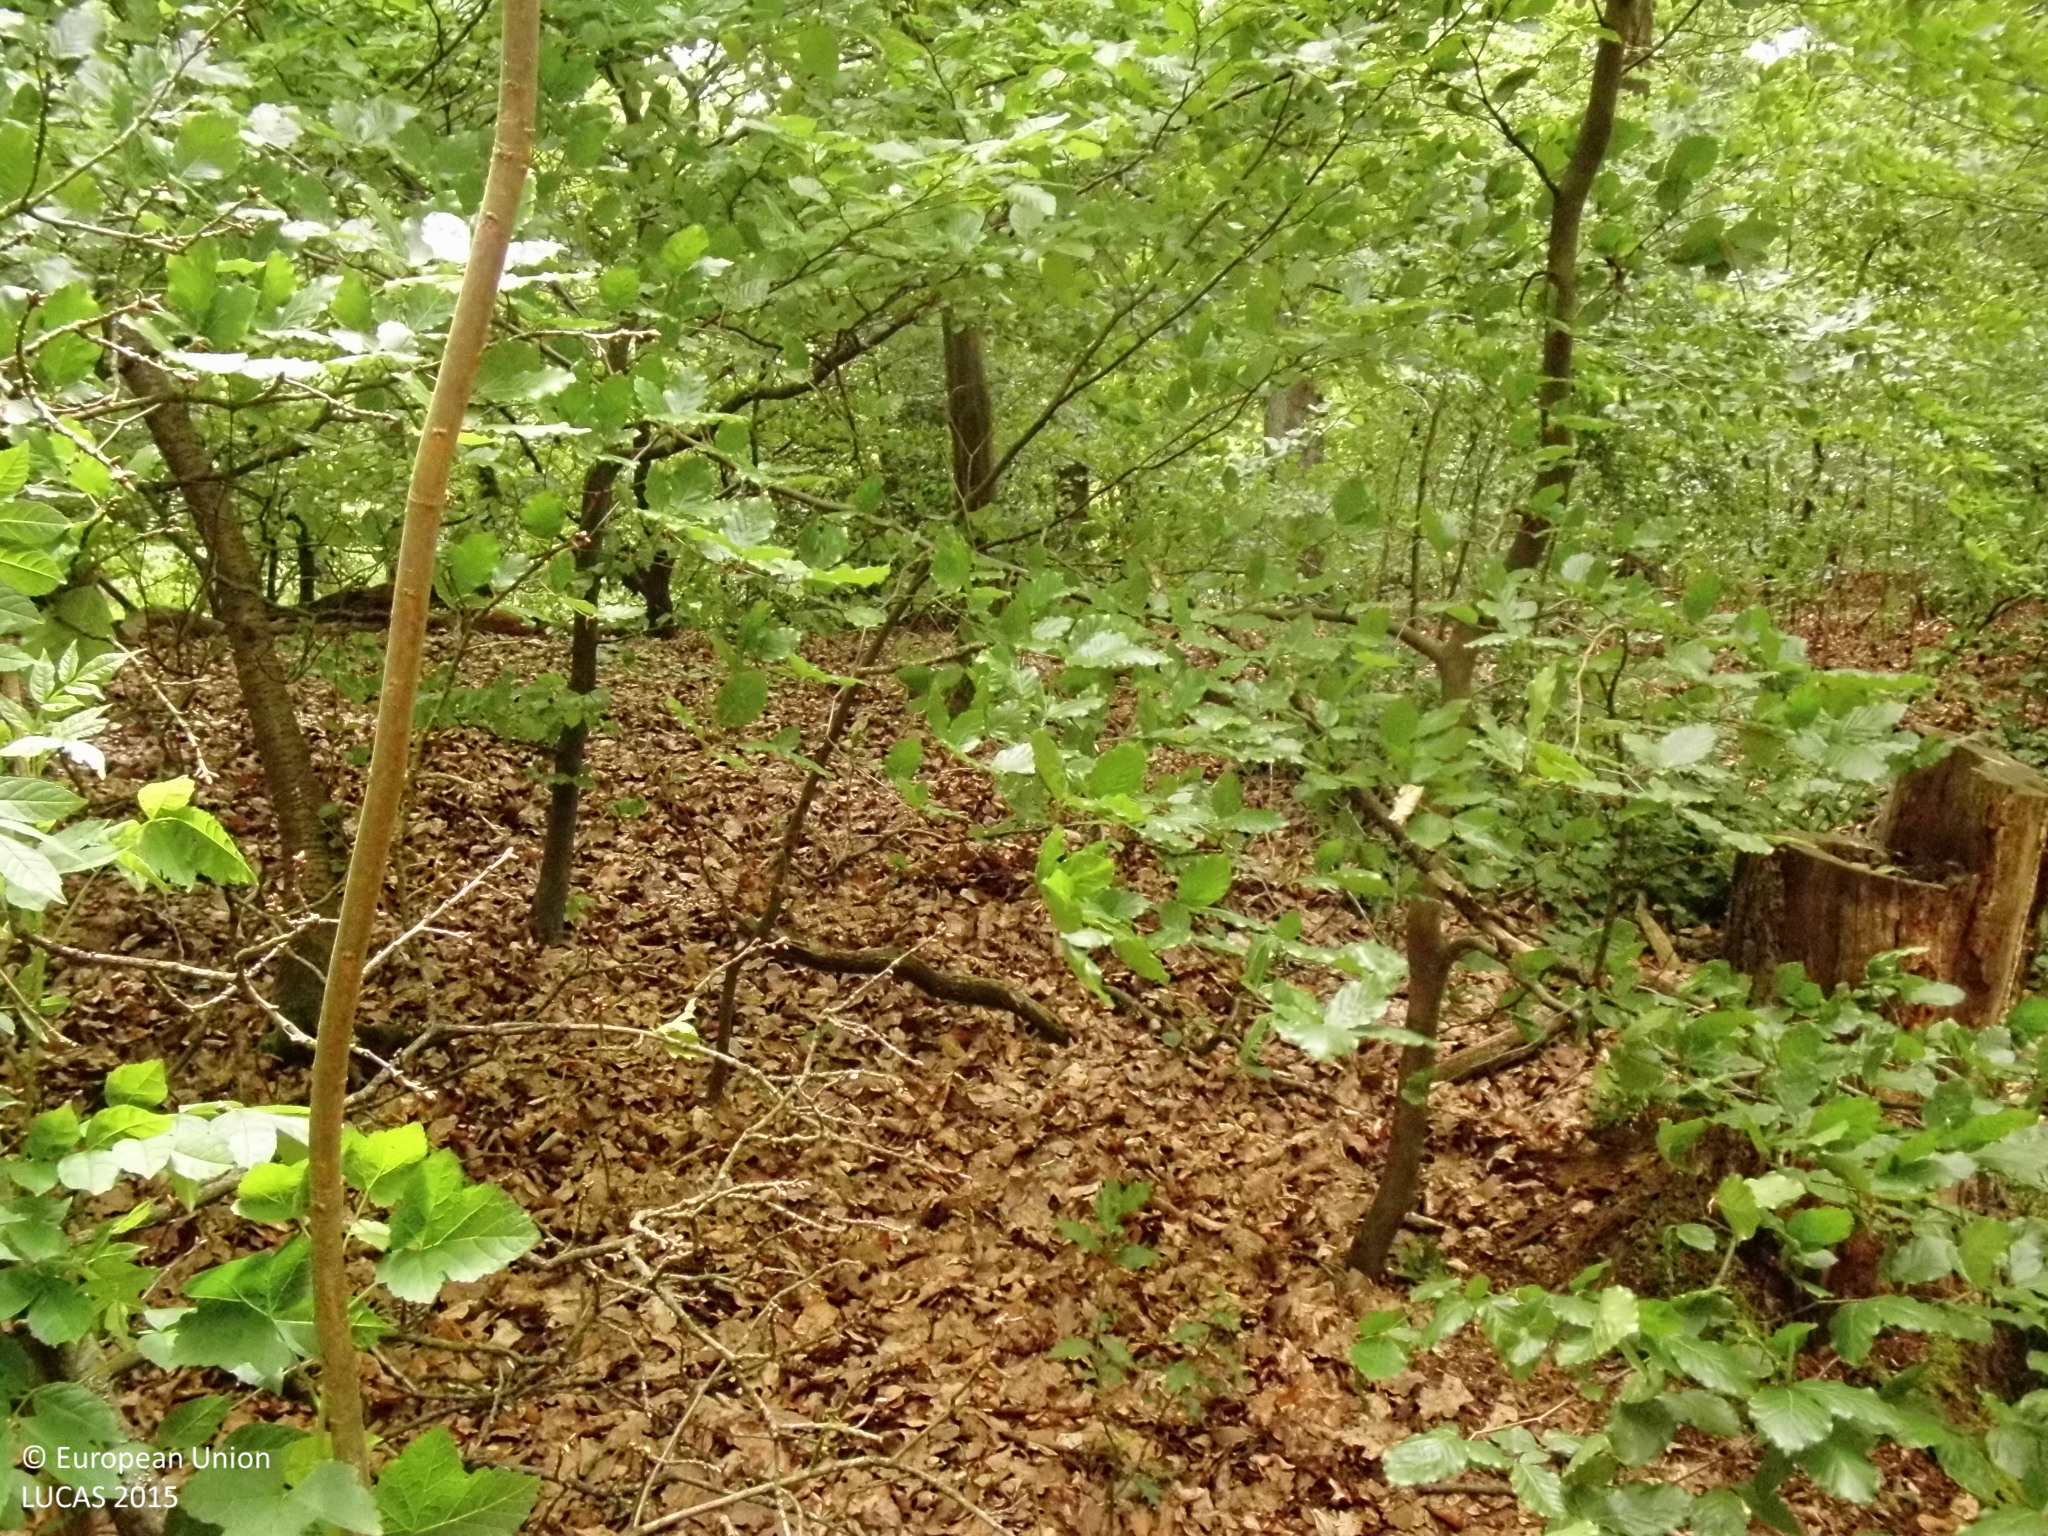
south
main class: Woodland
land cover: Broadleaved woodland
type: mesophytic deciduous forest
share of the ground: > 75 %
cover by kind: broadleaved forest trees 95 %, unconsolidated bare surface 5 %
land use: Forestry
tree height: > 5 m
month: May
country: DE
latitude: 51.3426
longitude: 7.4305
